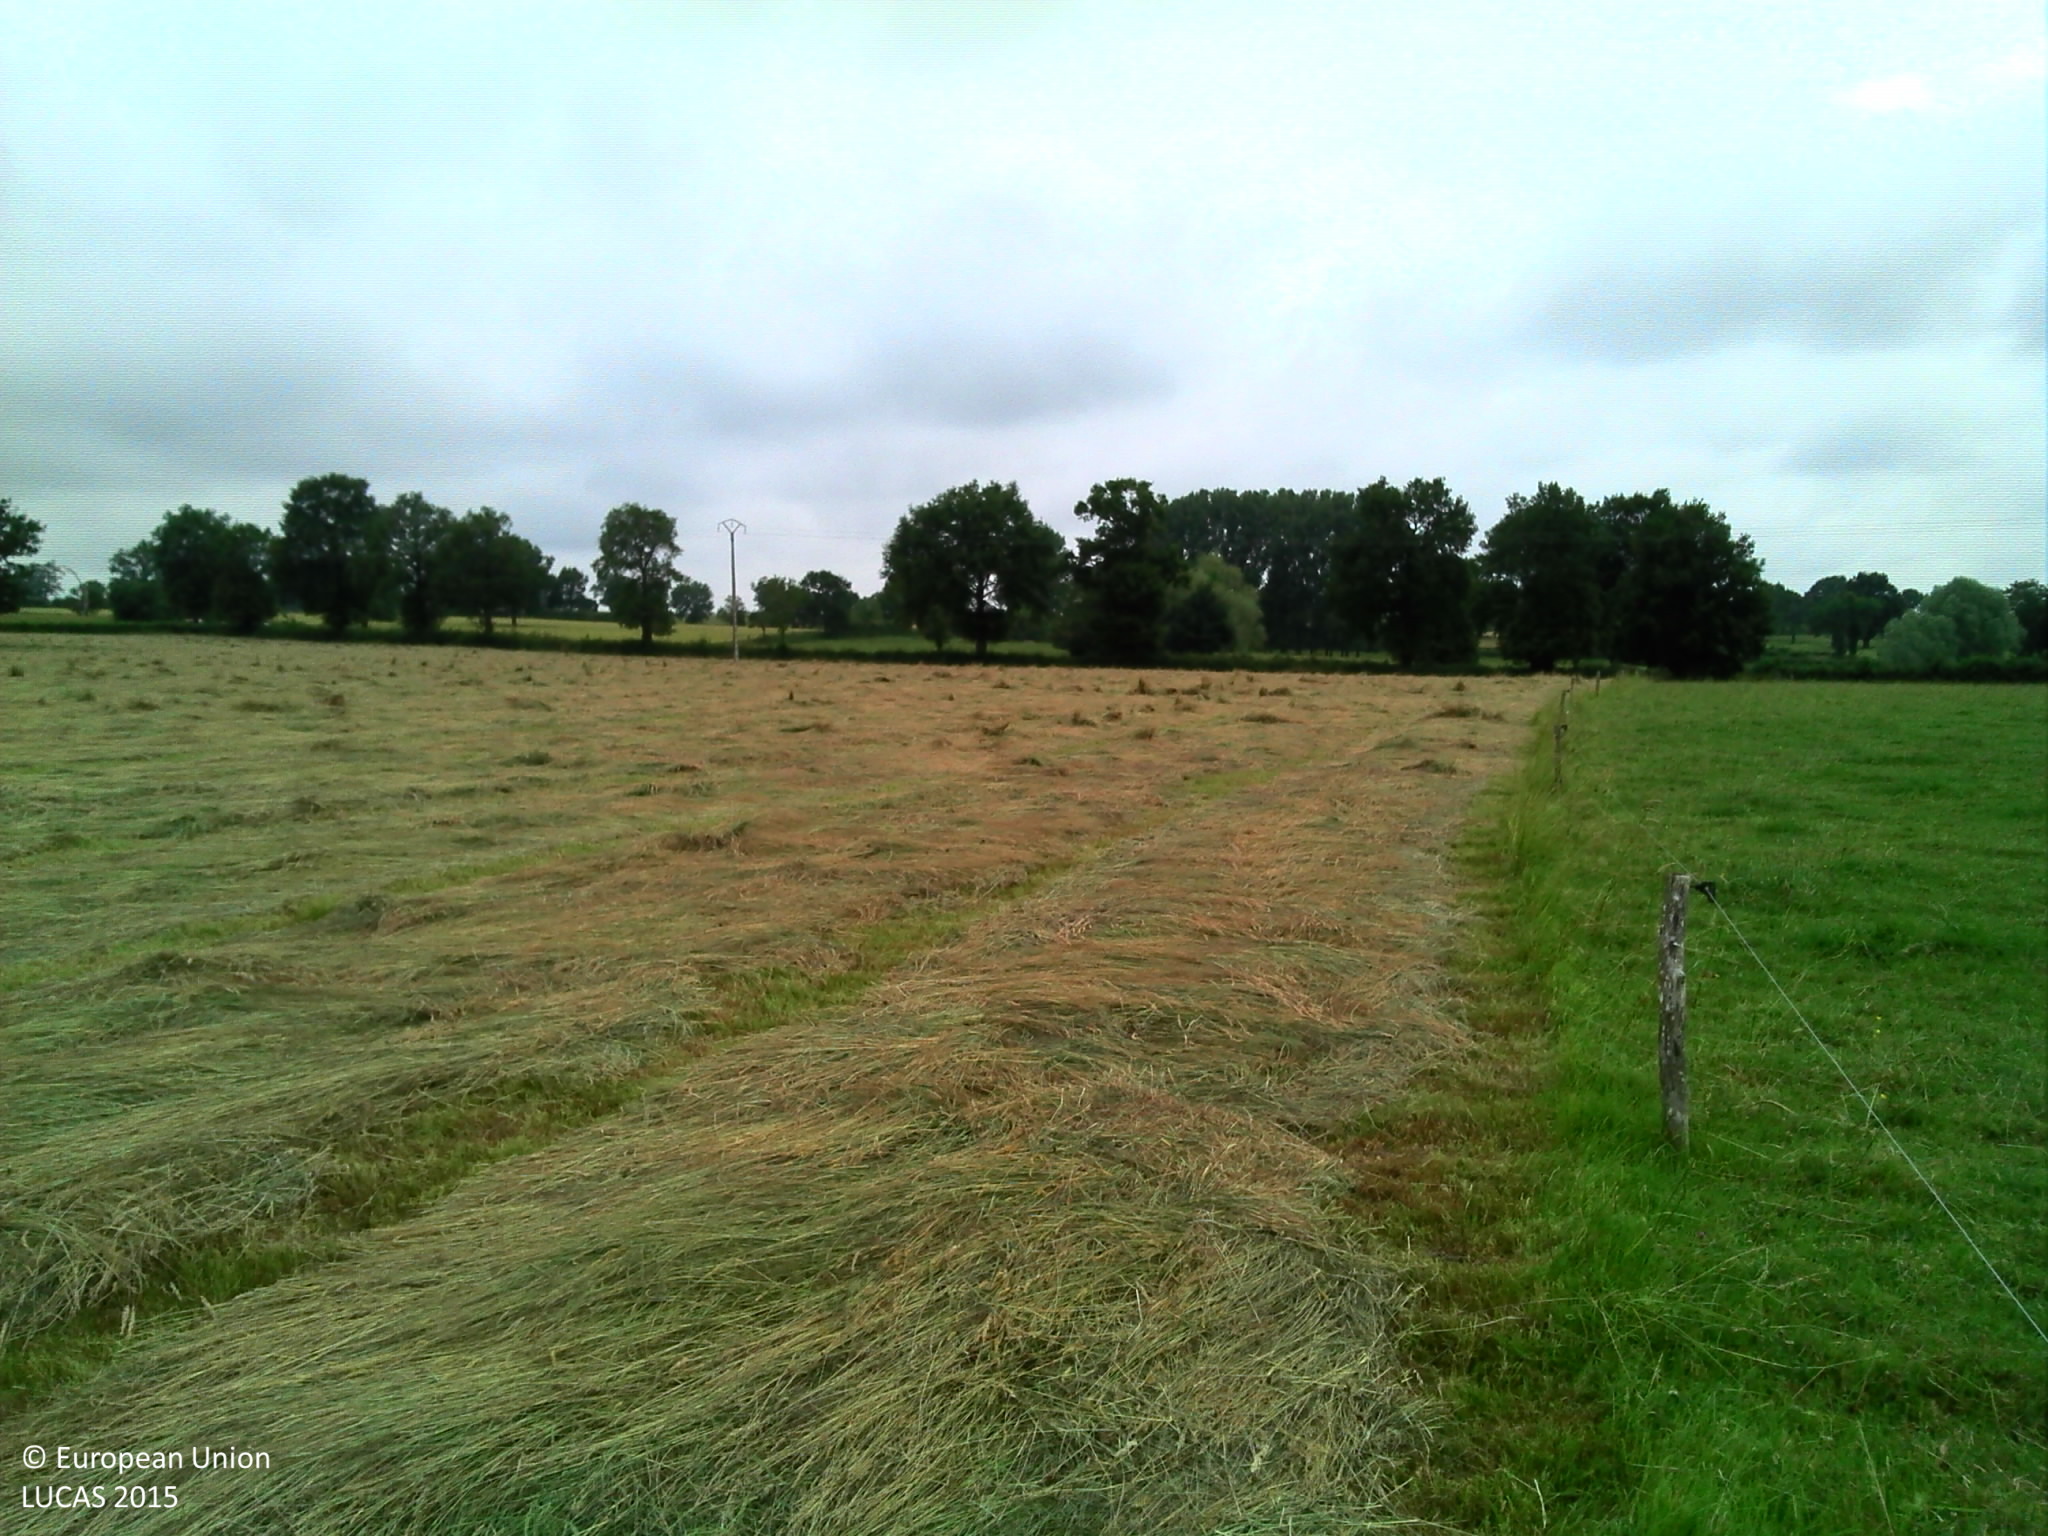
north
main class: Grassland
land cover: Grassland without tree/shrub cover
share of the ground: > 75 %
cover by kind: herbaceous plants 100 %
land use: Agriculture (excluding fallow land and kitchen gardens)
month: June
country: FR
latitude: 46.2880
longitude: 3.0537
